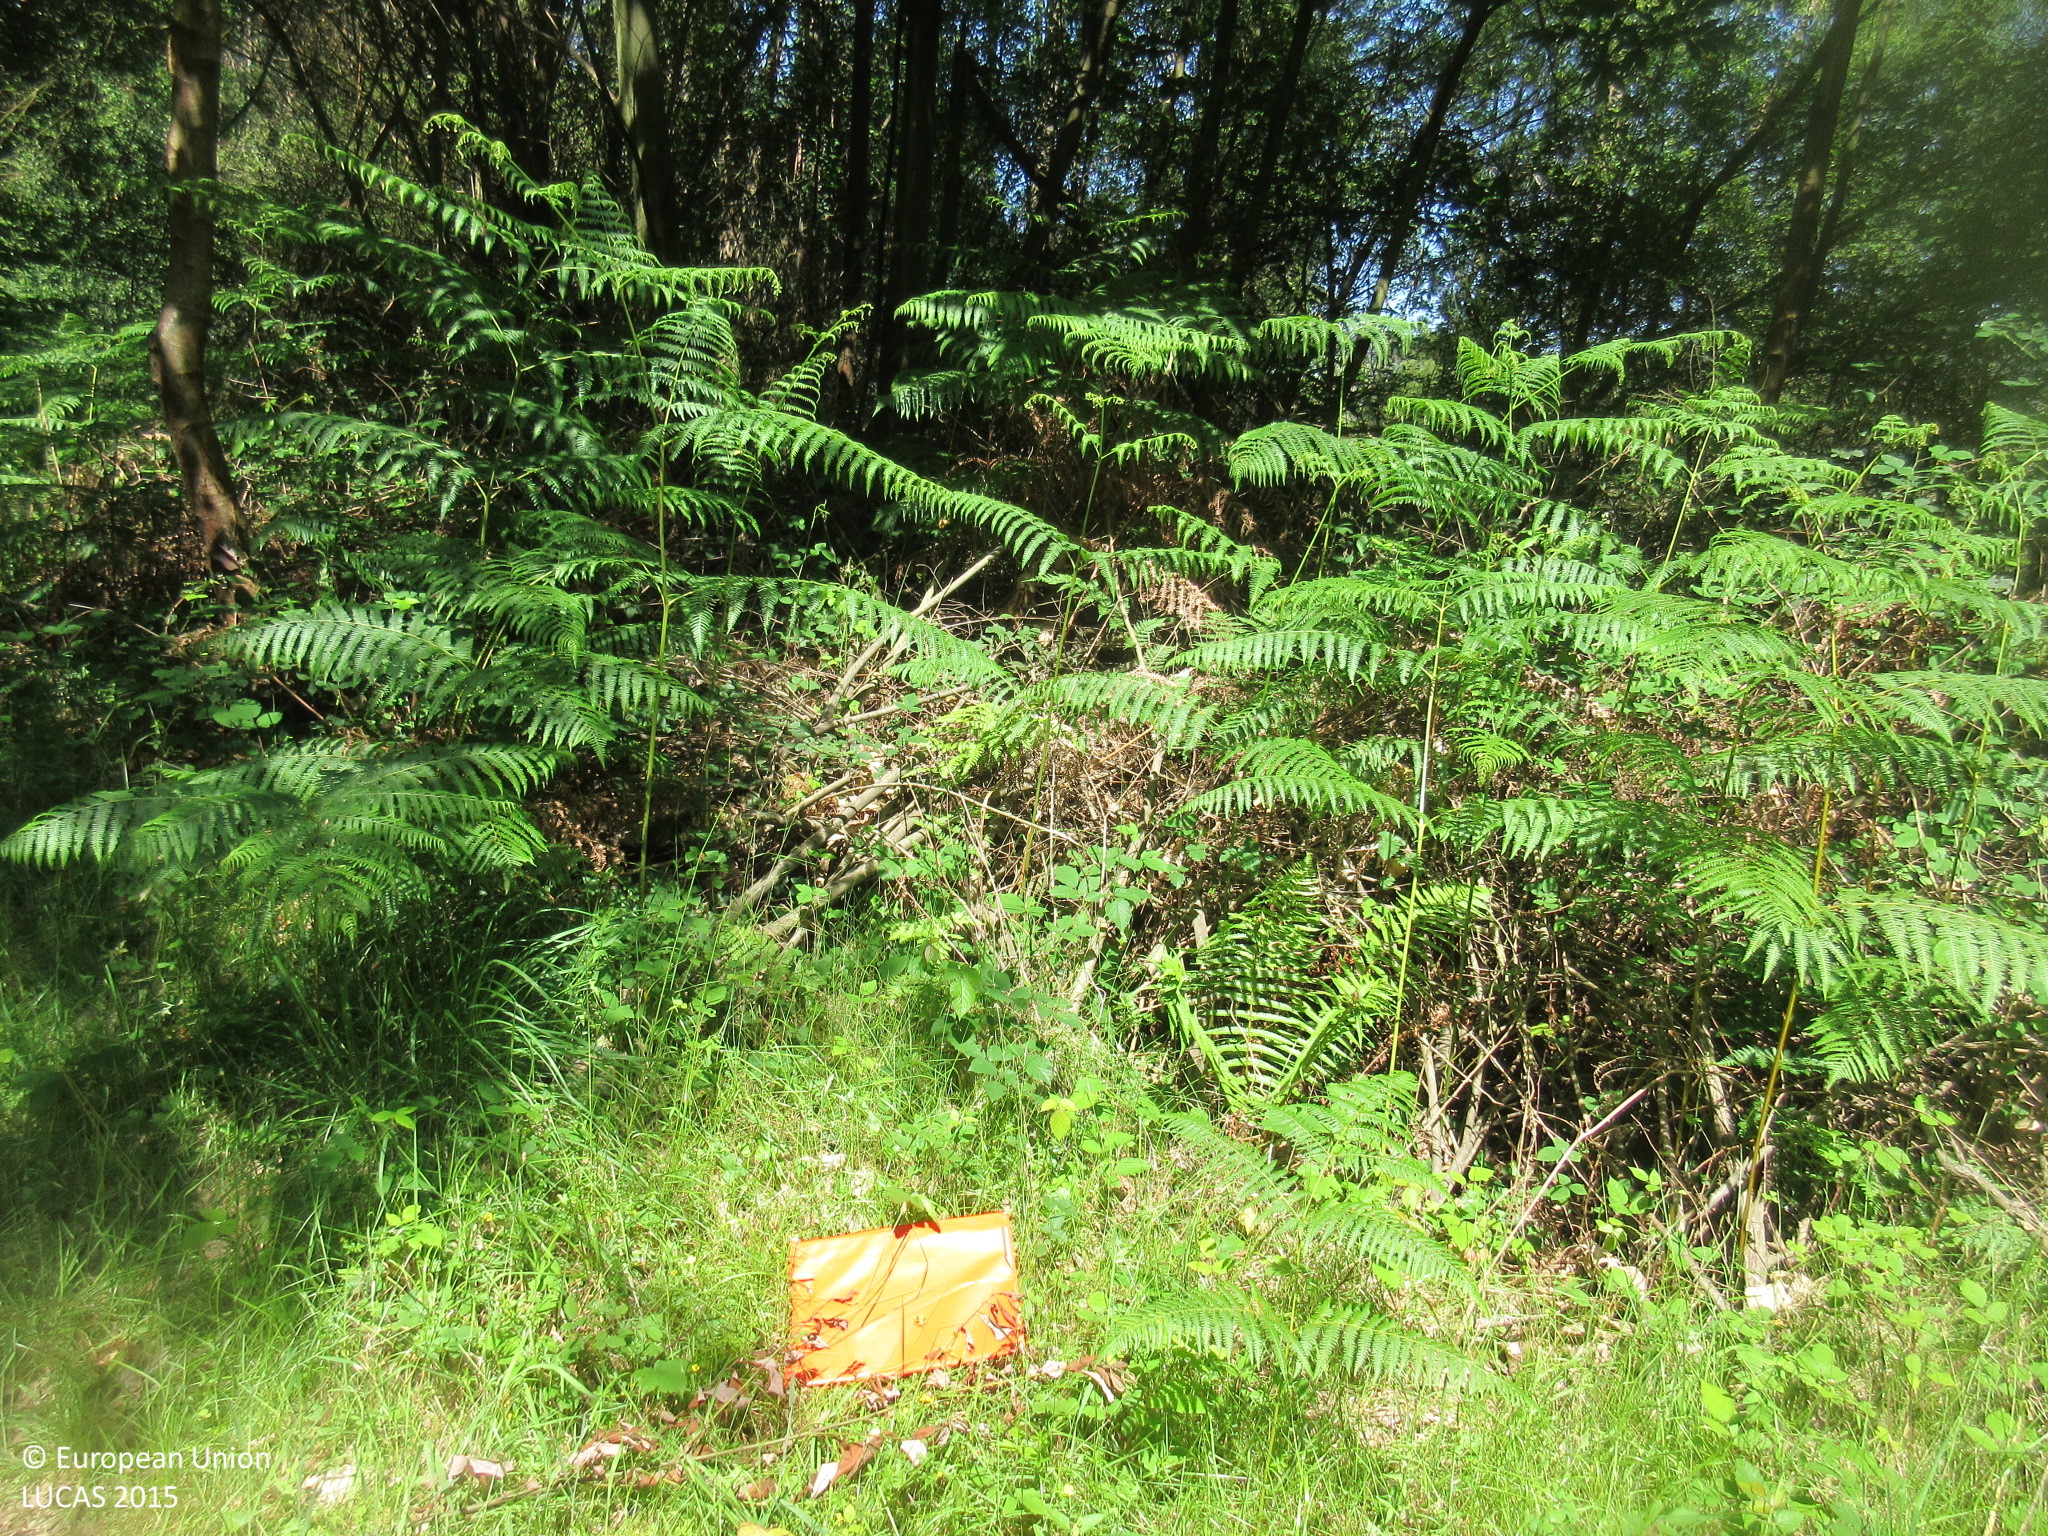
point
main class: Woodland
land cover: Broadleaved woodland
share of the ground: > 75 %
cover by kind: broadleaved forest trees 90 %, shrubs 10 %
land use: Forestry
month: June
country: ES
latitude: 43.4665
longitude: -6.0005
